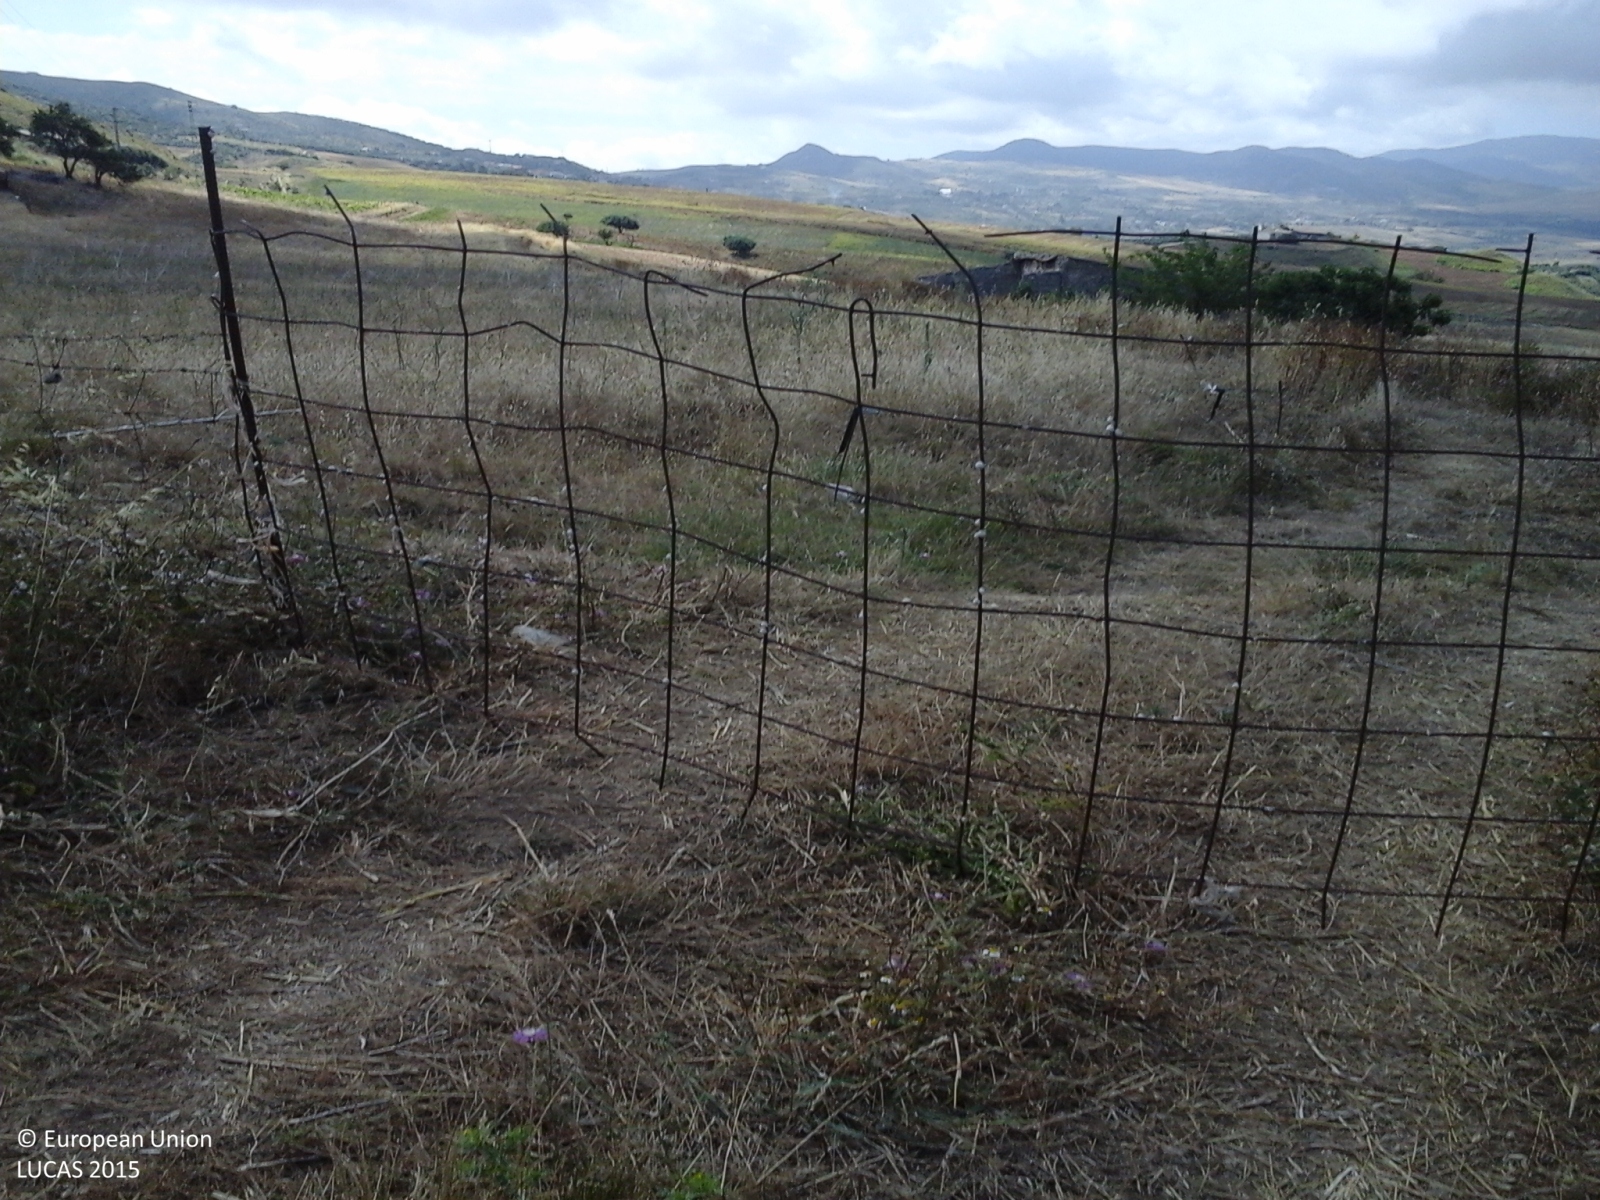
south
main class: Grassland
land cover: Spontaneously vegetated surfaces
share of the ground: > 75 %
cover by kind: herbaceous plants 100 %
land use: Fallow land
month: June
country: IT
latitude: 37.9257
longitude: 13.8069
